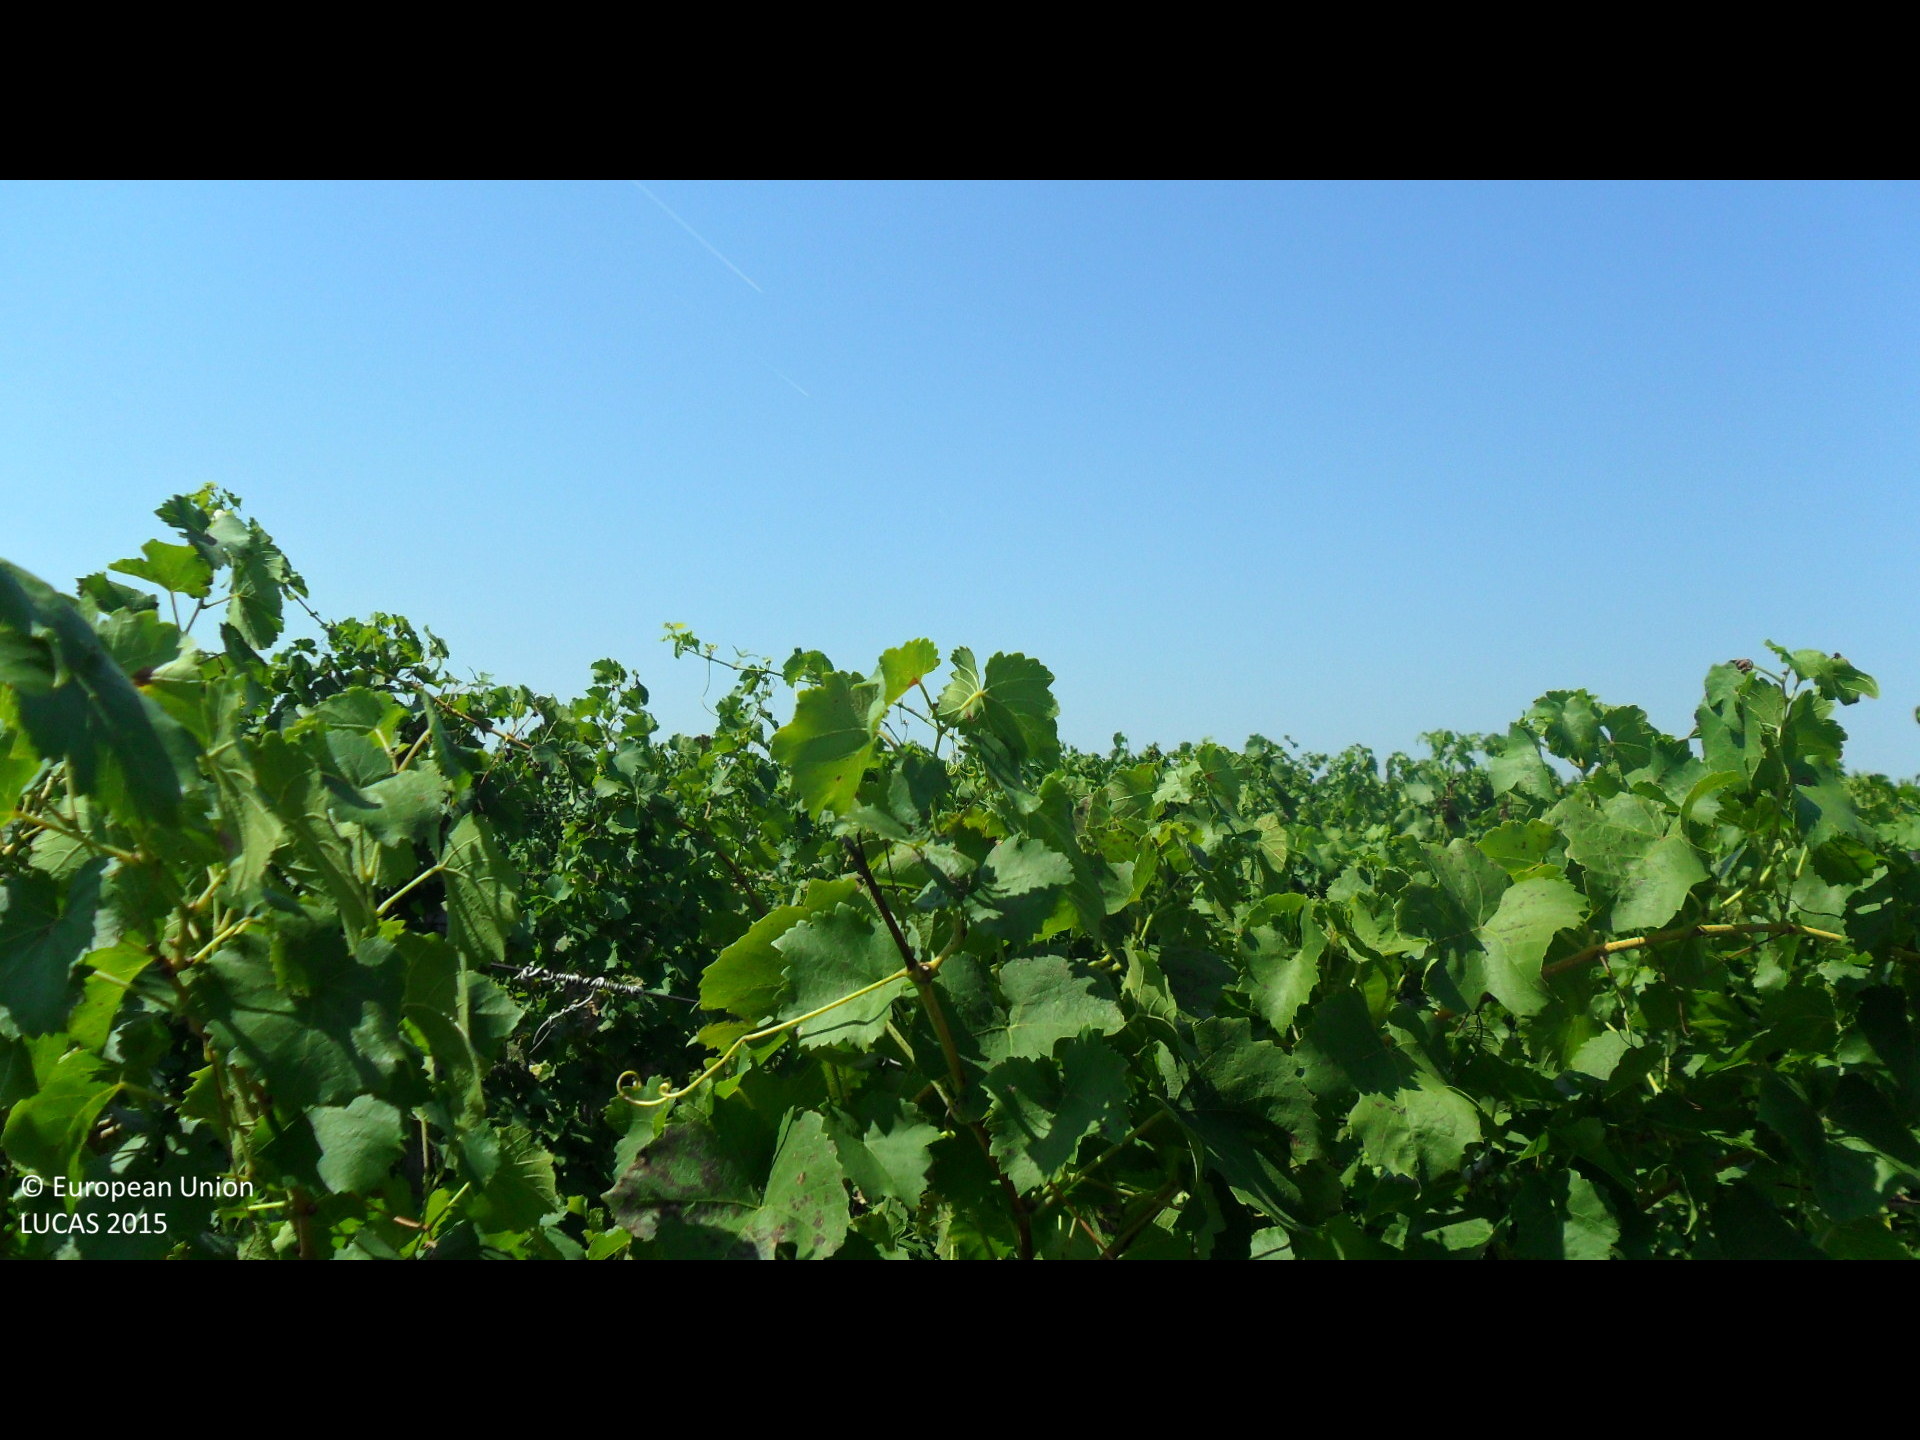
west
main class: Cropland
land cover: Vineyards
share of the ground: > 75 %
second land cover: Grassland without tree/shrub cover
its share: 25 - 50 %
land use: Agriculture (excluding fallow land and kitchen gardens)
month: August
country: BG
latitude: 43.2142
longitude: 26.7626
